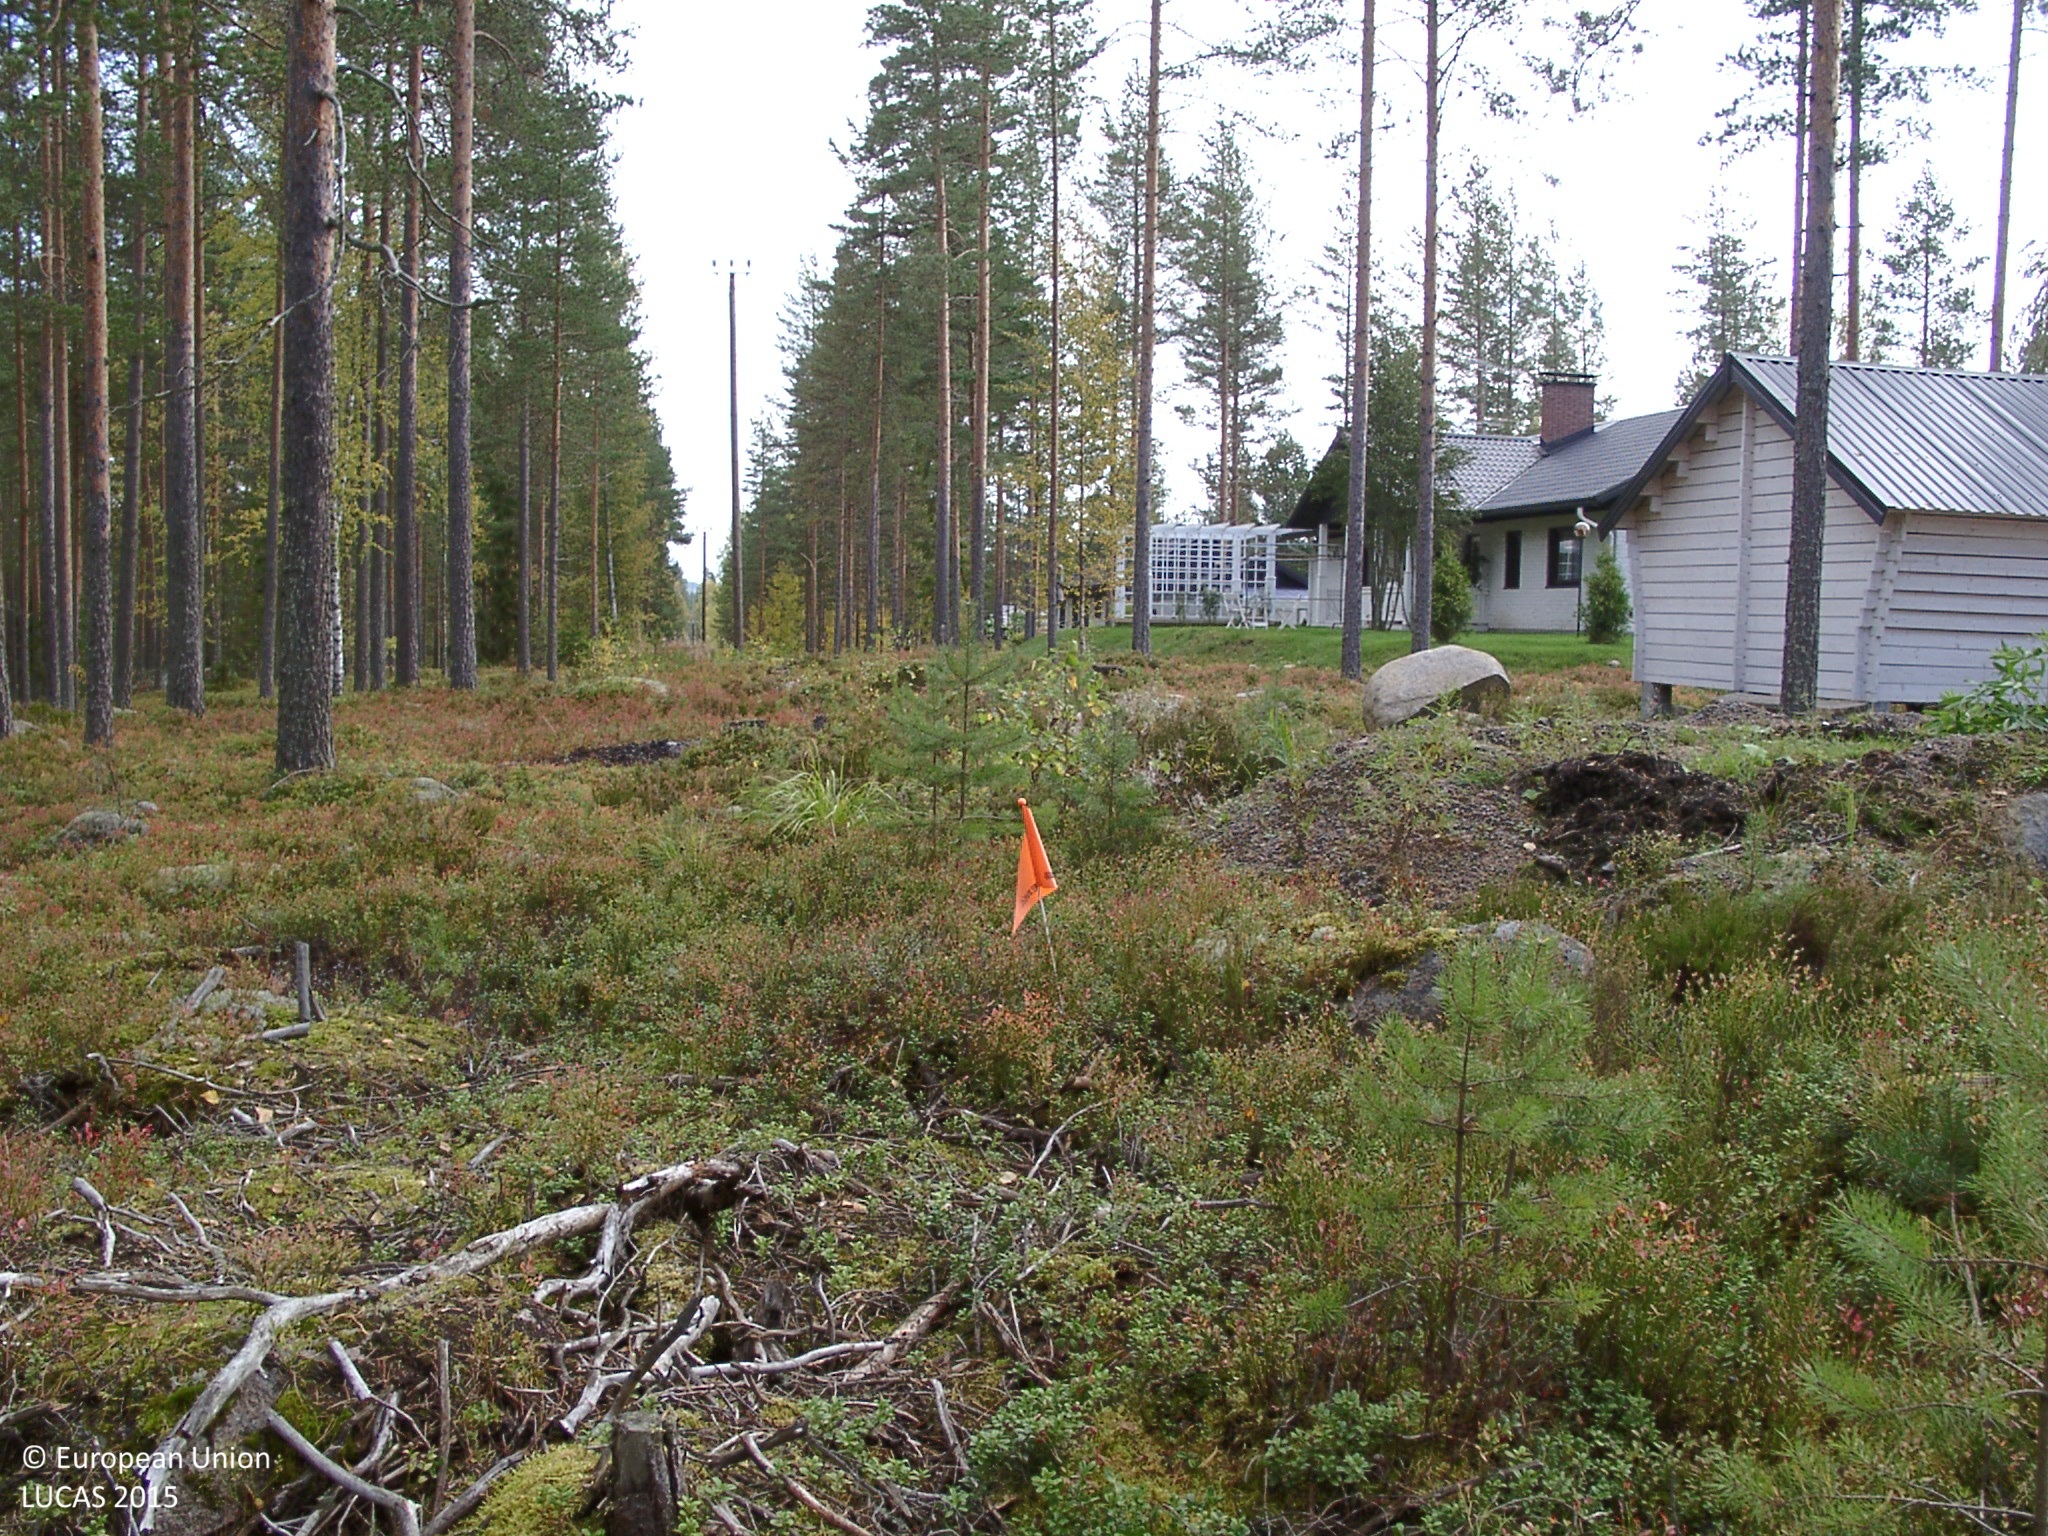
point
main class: Shrubland
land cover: Shrubland without tree cover
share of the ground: > 75 %
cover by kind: shrubs 80 %, lichens and mosses 20 %
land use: Electricity, gas and thermal power distribution
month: September
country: FI
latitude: 62.6837
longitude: 25.3618
